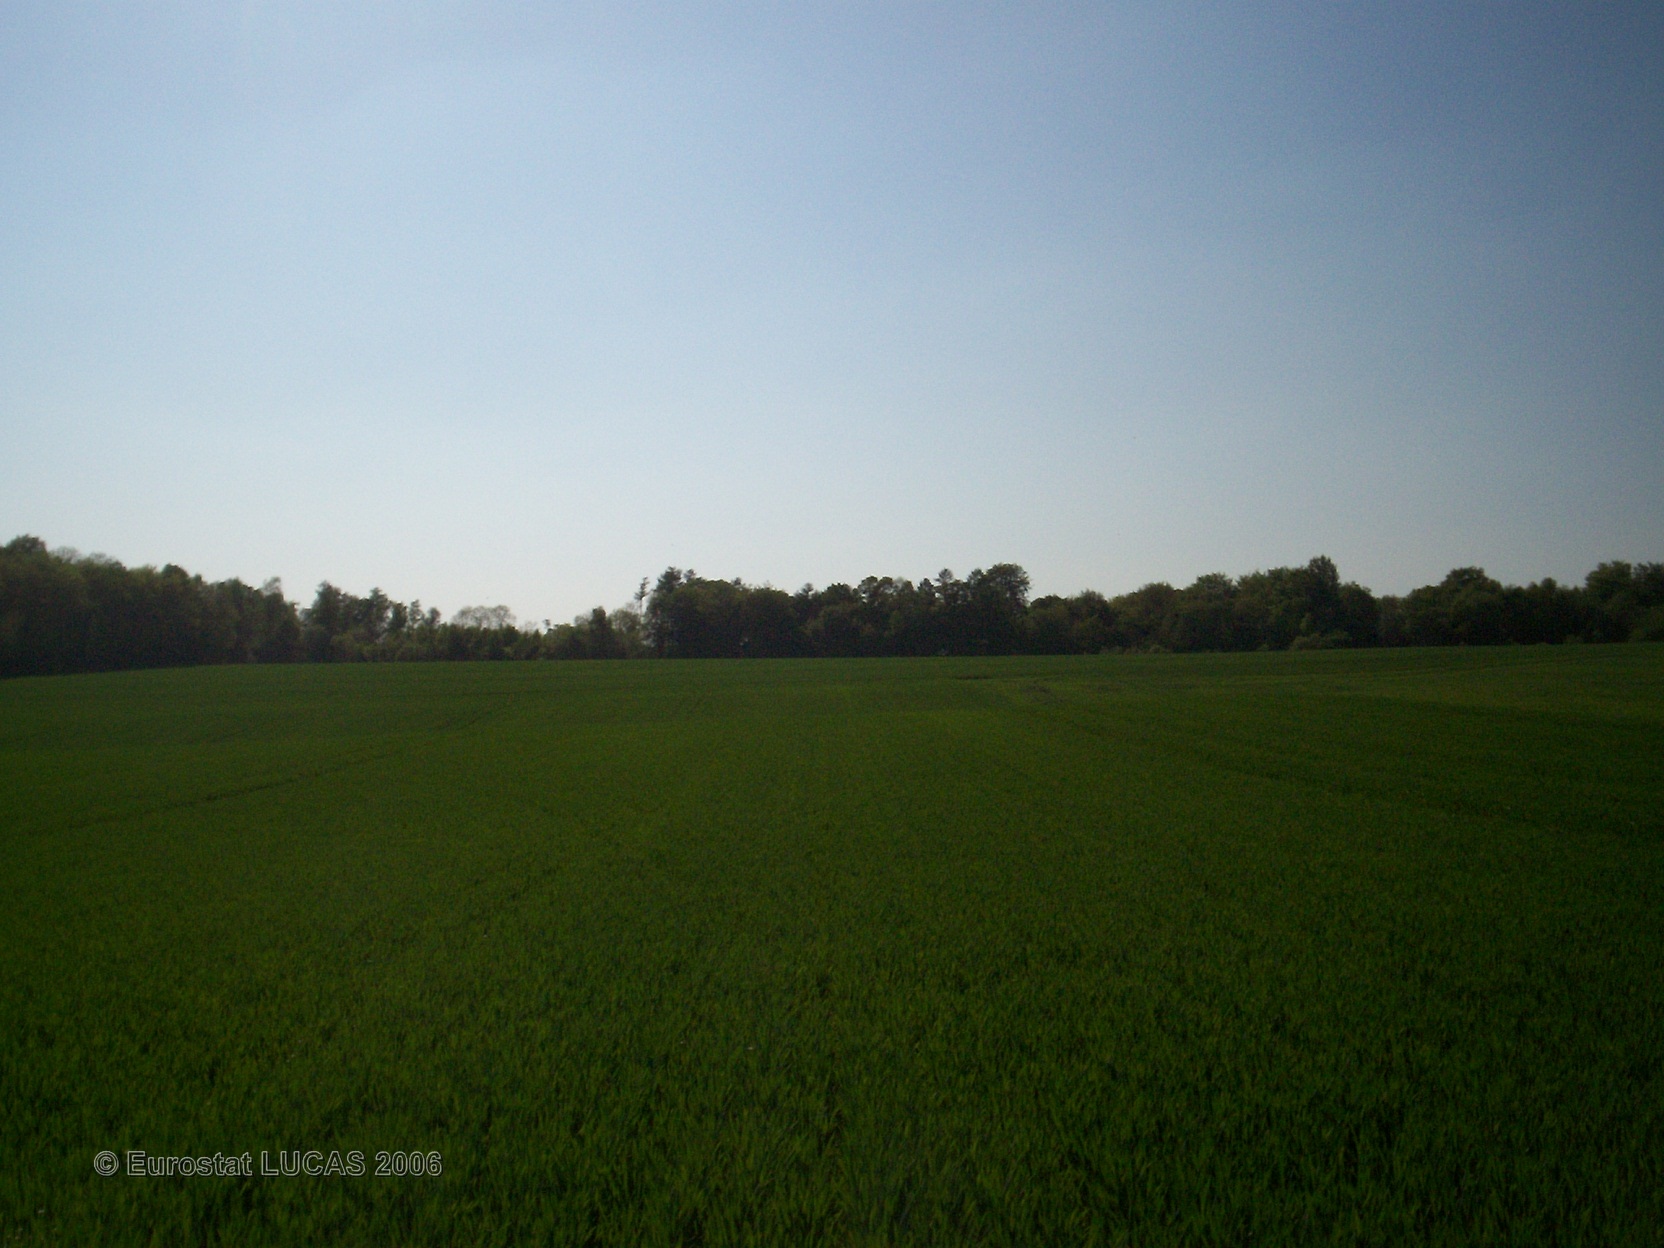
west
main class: Cropland
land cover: Common wheat
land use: Agriculture (excluding fallow land and kitchen gardens)
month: May
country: FR
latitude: 49.7151
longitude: 5.0185
